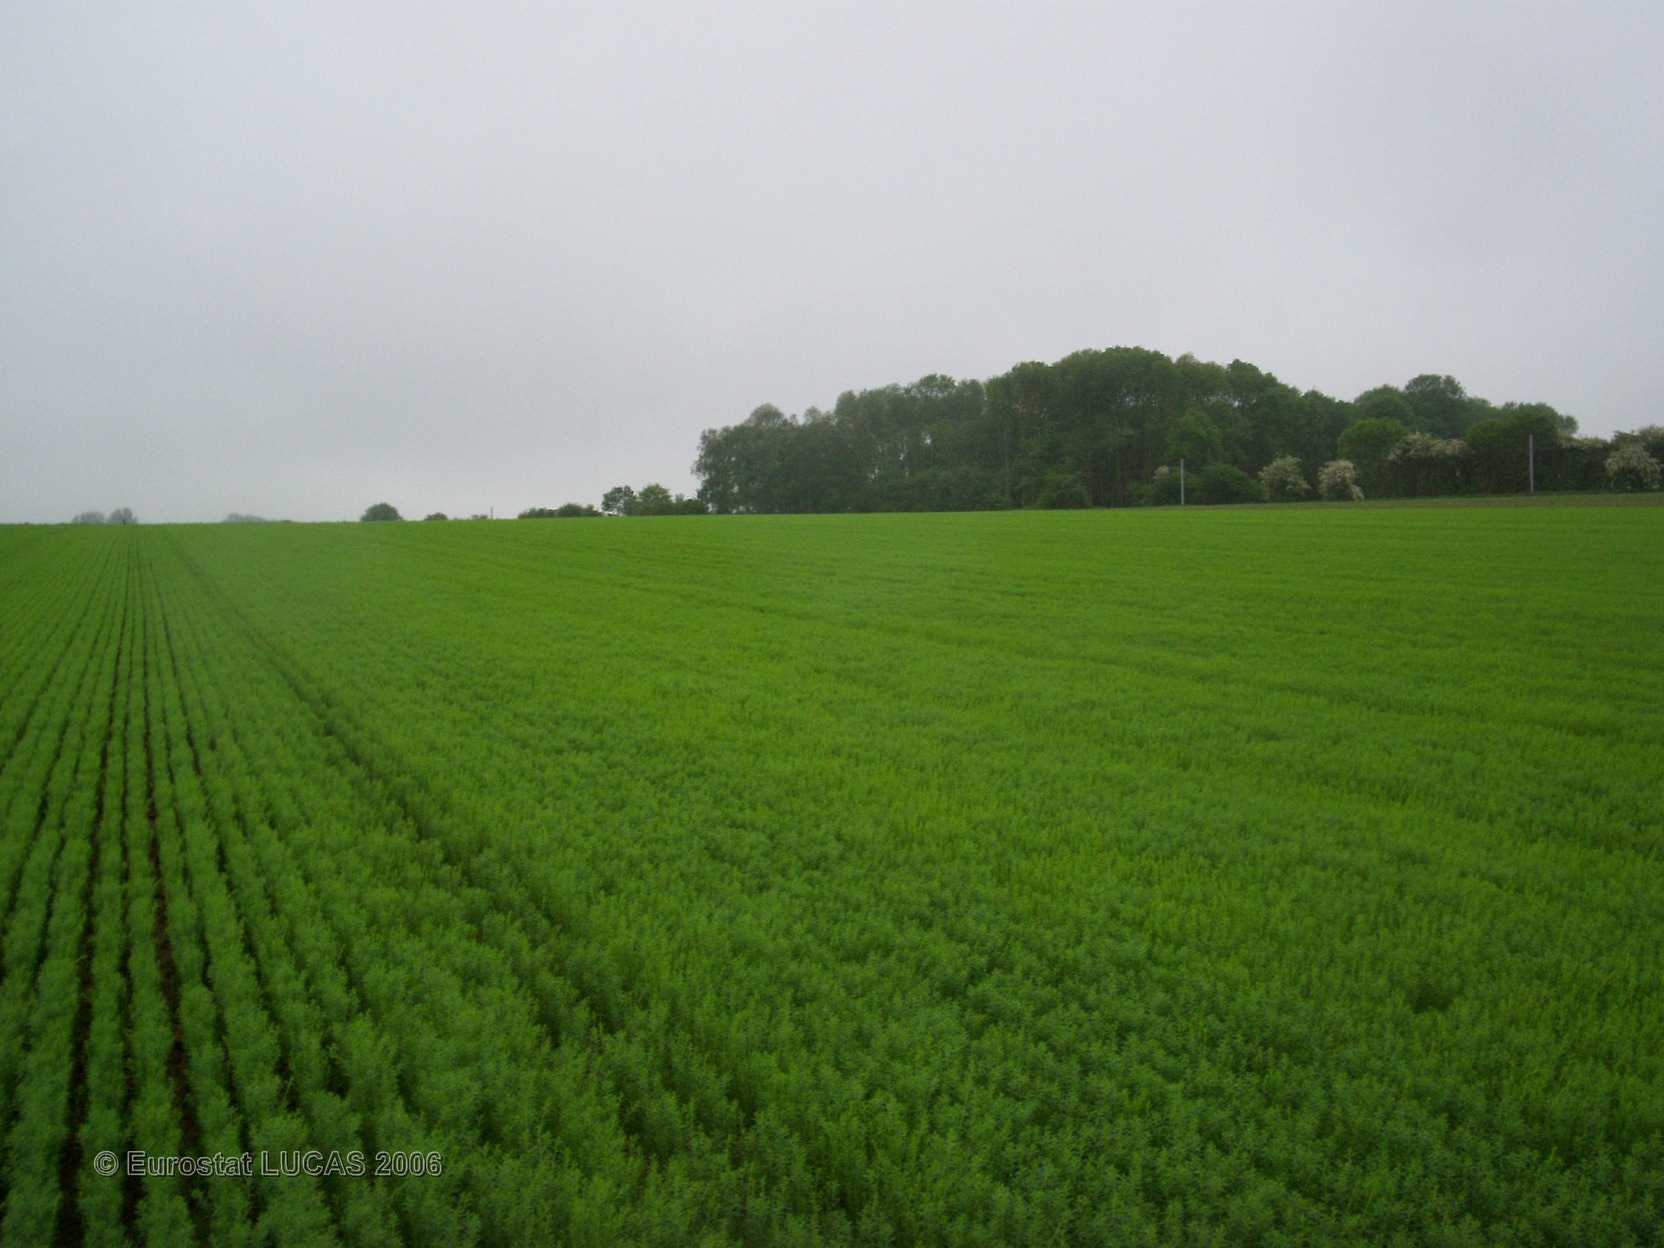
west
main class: Cropland
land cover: Other fibre and oleaginous crops
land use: Agriculture (excluding fallow land and kitchen gardens)
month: May
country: FR
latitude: 49.6392
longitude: 0.9067
